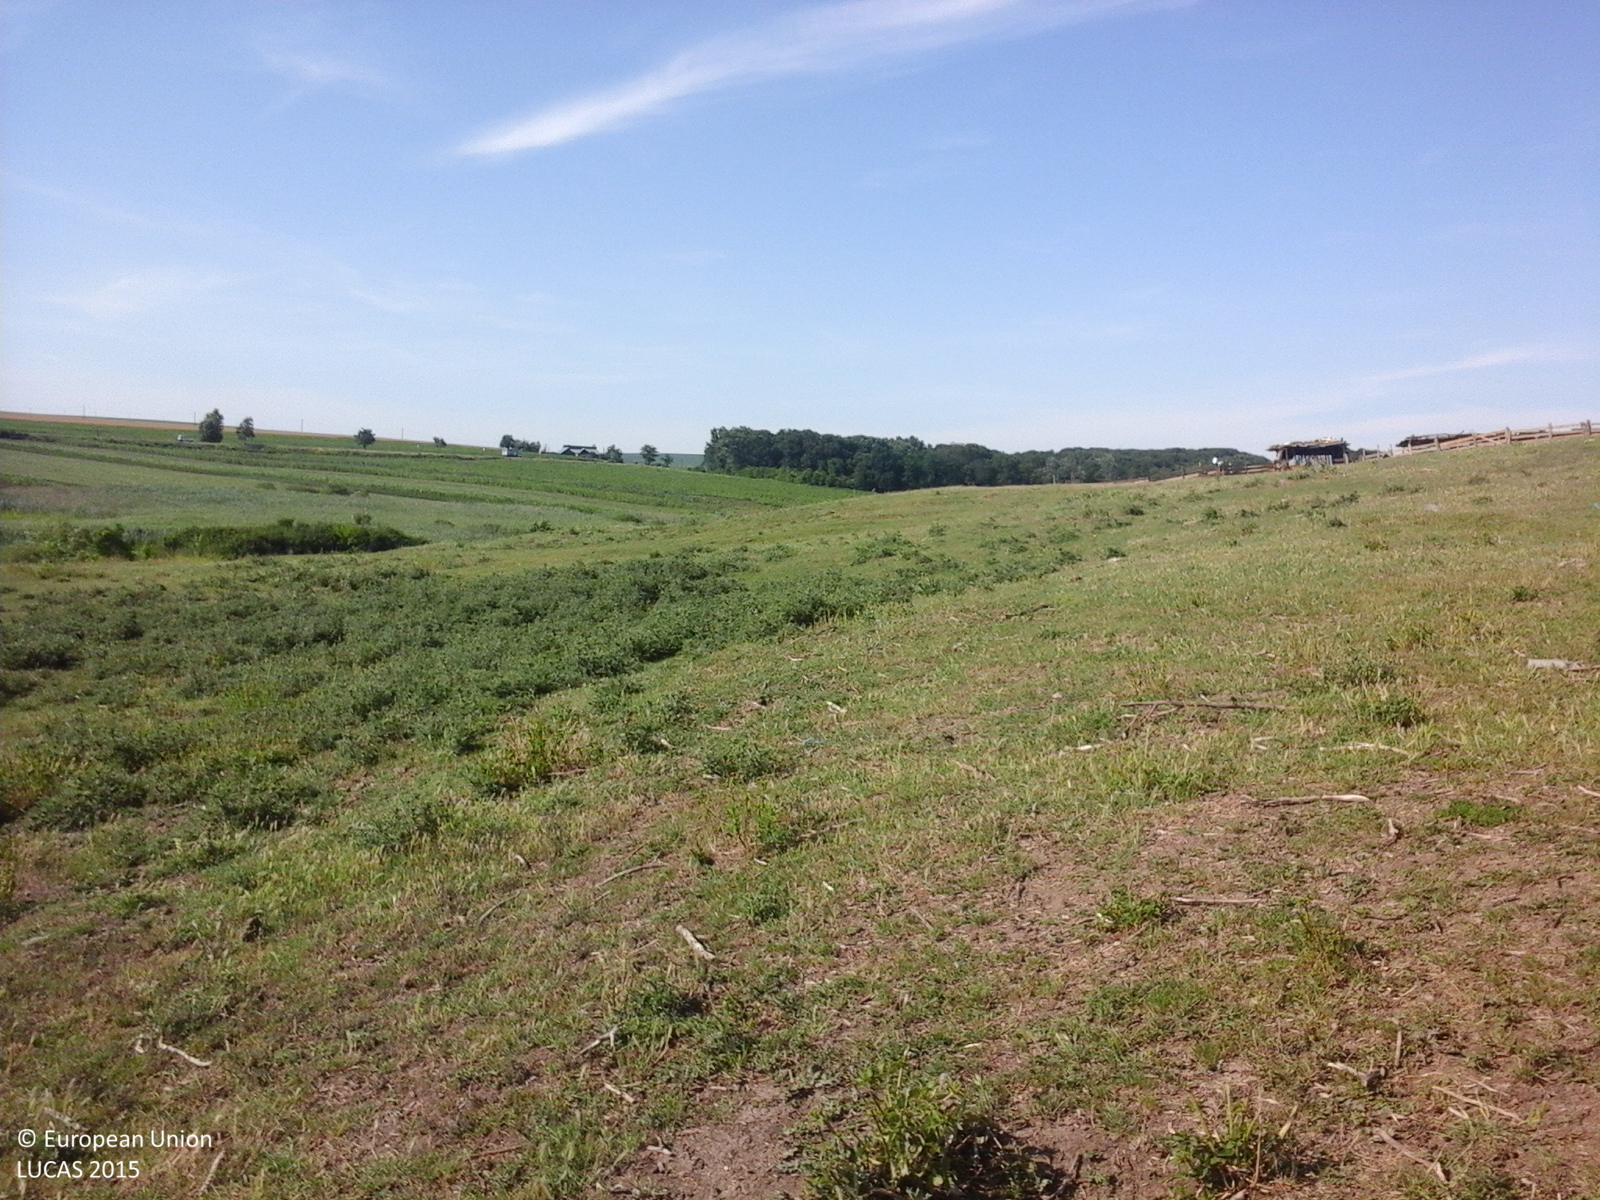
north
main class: Grassland
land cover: Grassland without tree/shrub cover
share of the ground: > 75 %
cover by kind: herbaceous plants 100 %
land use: Agriculture (excluding fallow land and kitchen gardens)
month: June
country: RO
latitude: 47.0868
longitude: 26.9191
